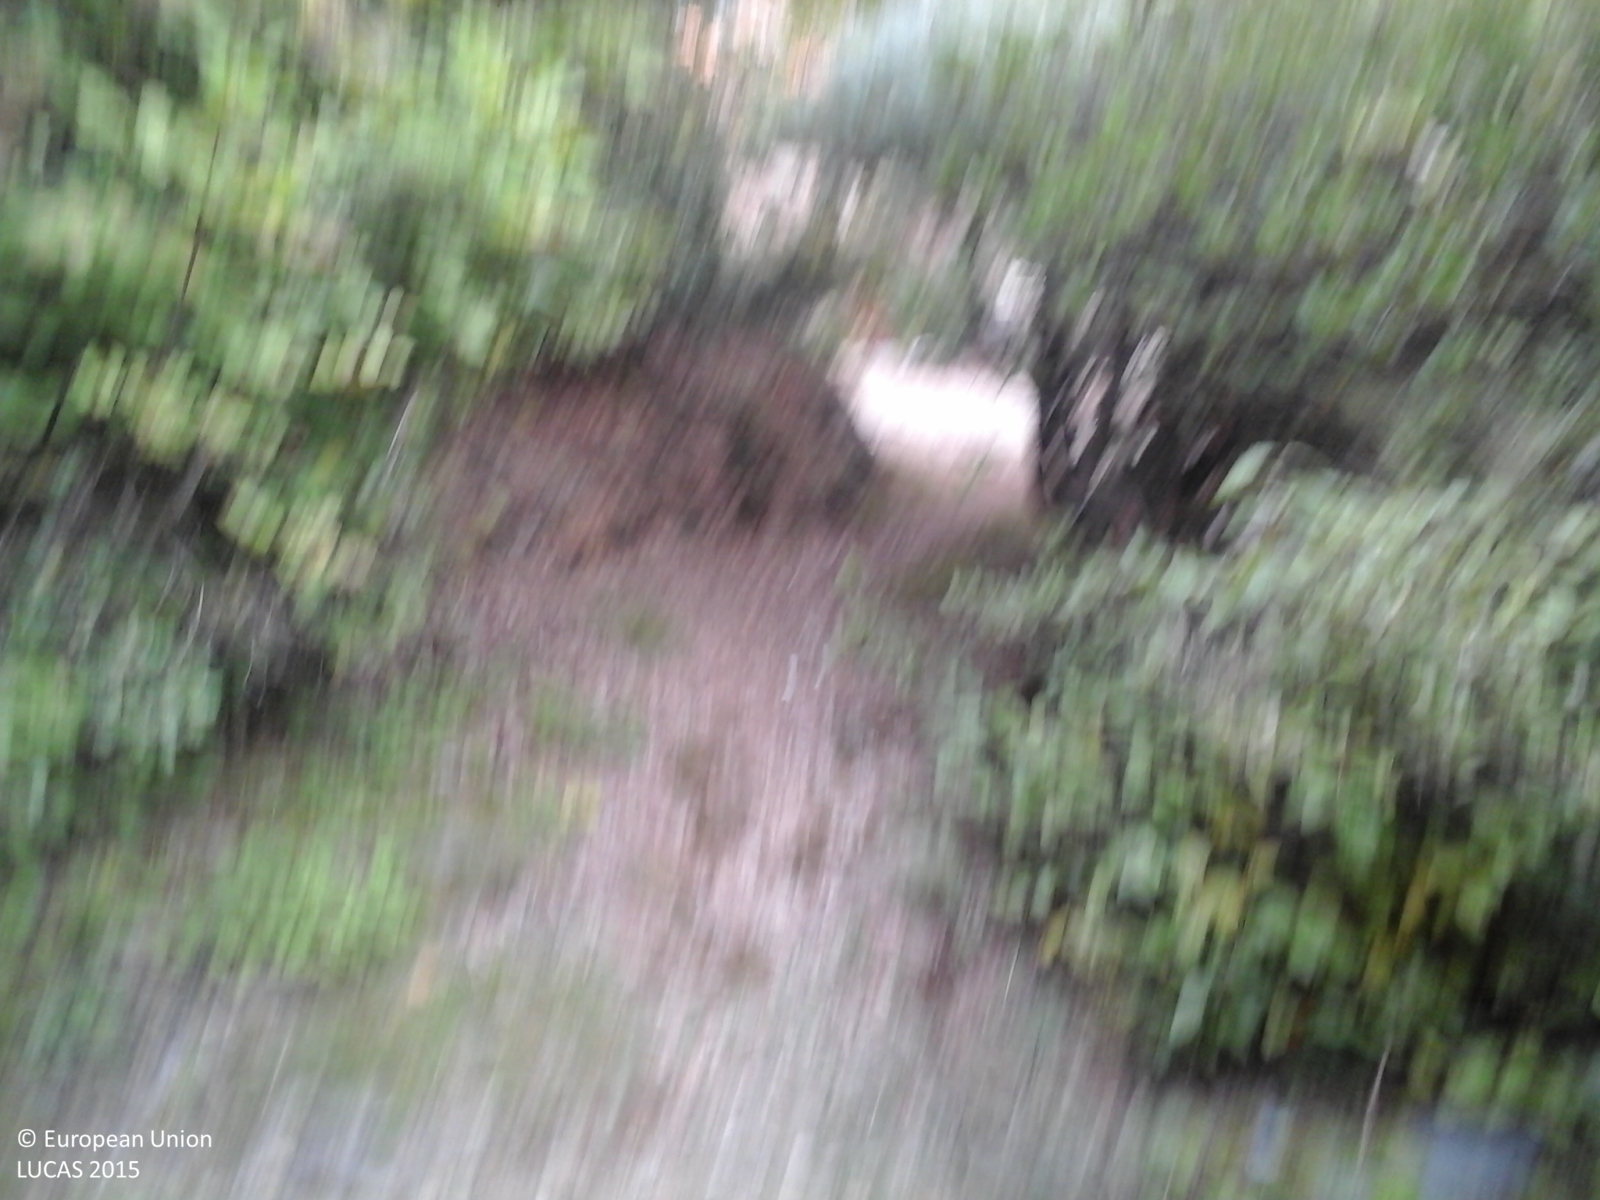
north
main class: Woodland
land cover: Broadleaved woodland
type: broadleaved evergreen forest
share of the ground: > 75 %
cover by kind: broadleaved forest trees 70 %, coniferous forest trees 10 %, shrubs 10 %, herbaceous plants 5 %, consolidated bare surface 5 %
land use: Semi-natural and natural areas not in use
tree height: > 5 m
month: September
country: IT
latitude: 44.1183
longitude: 8.1924
